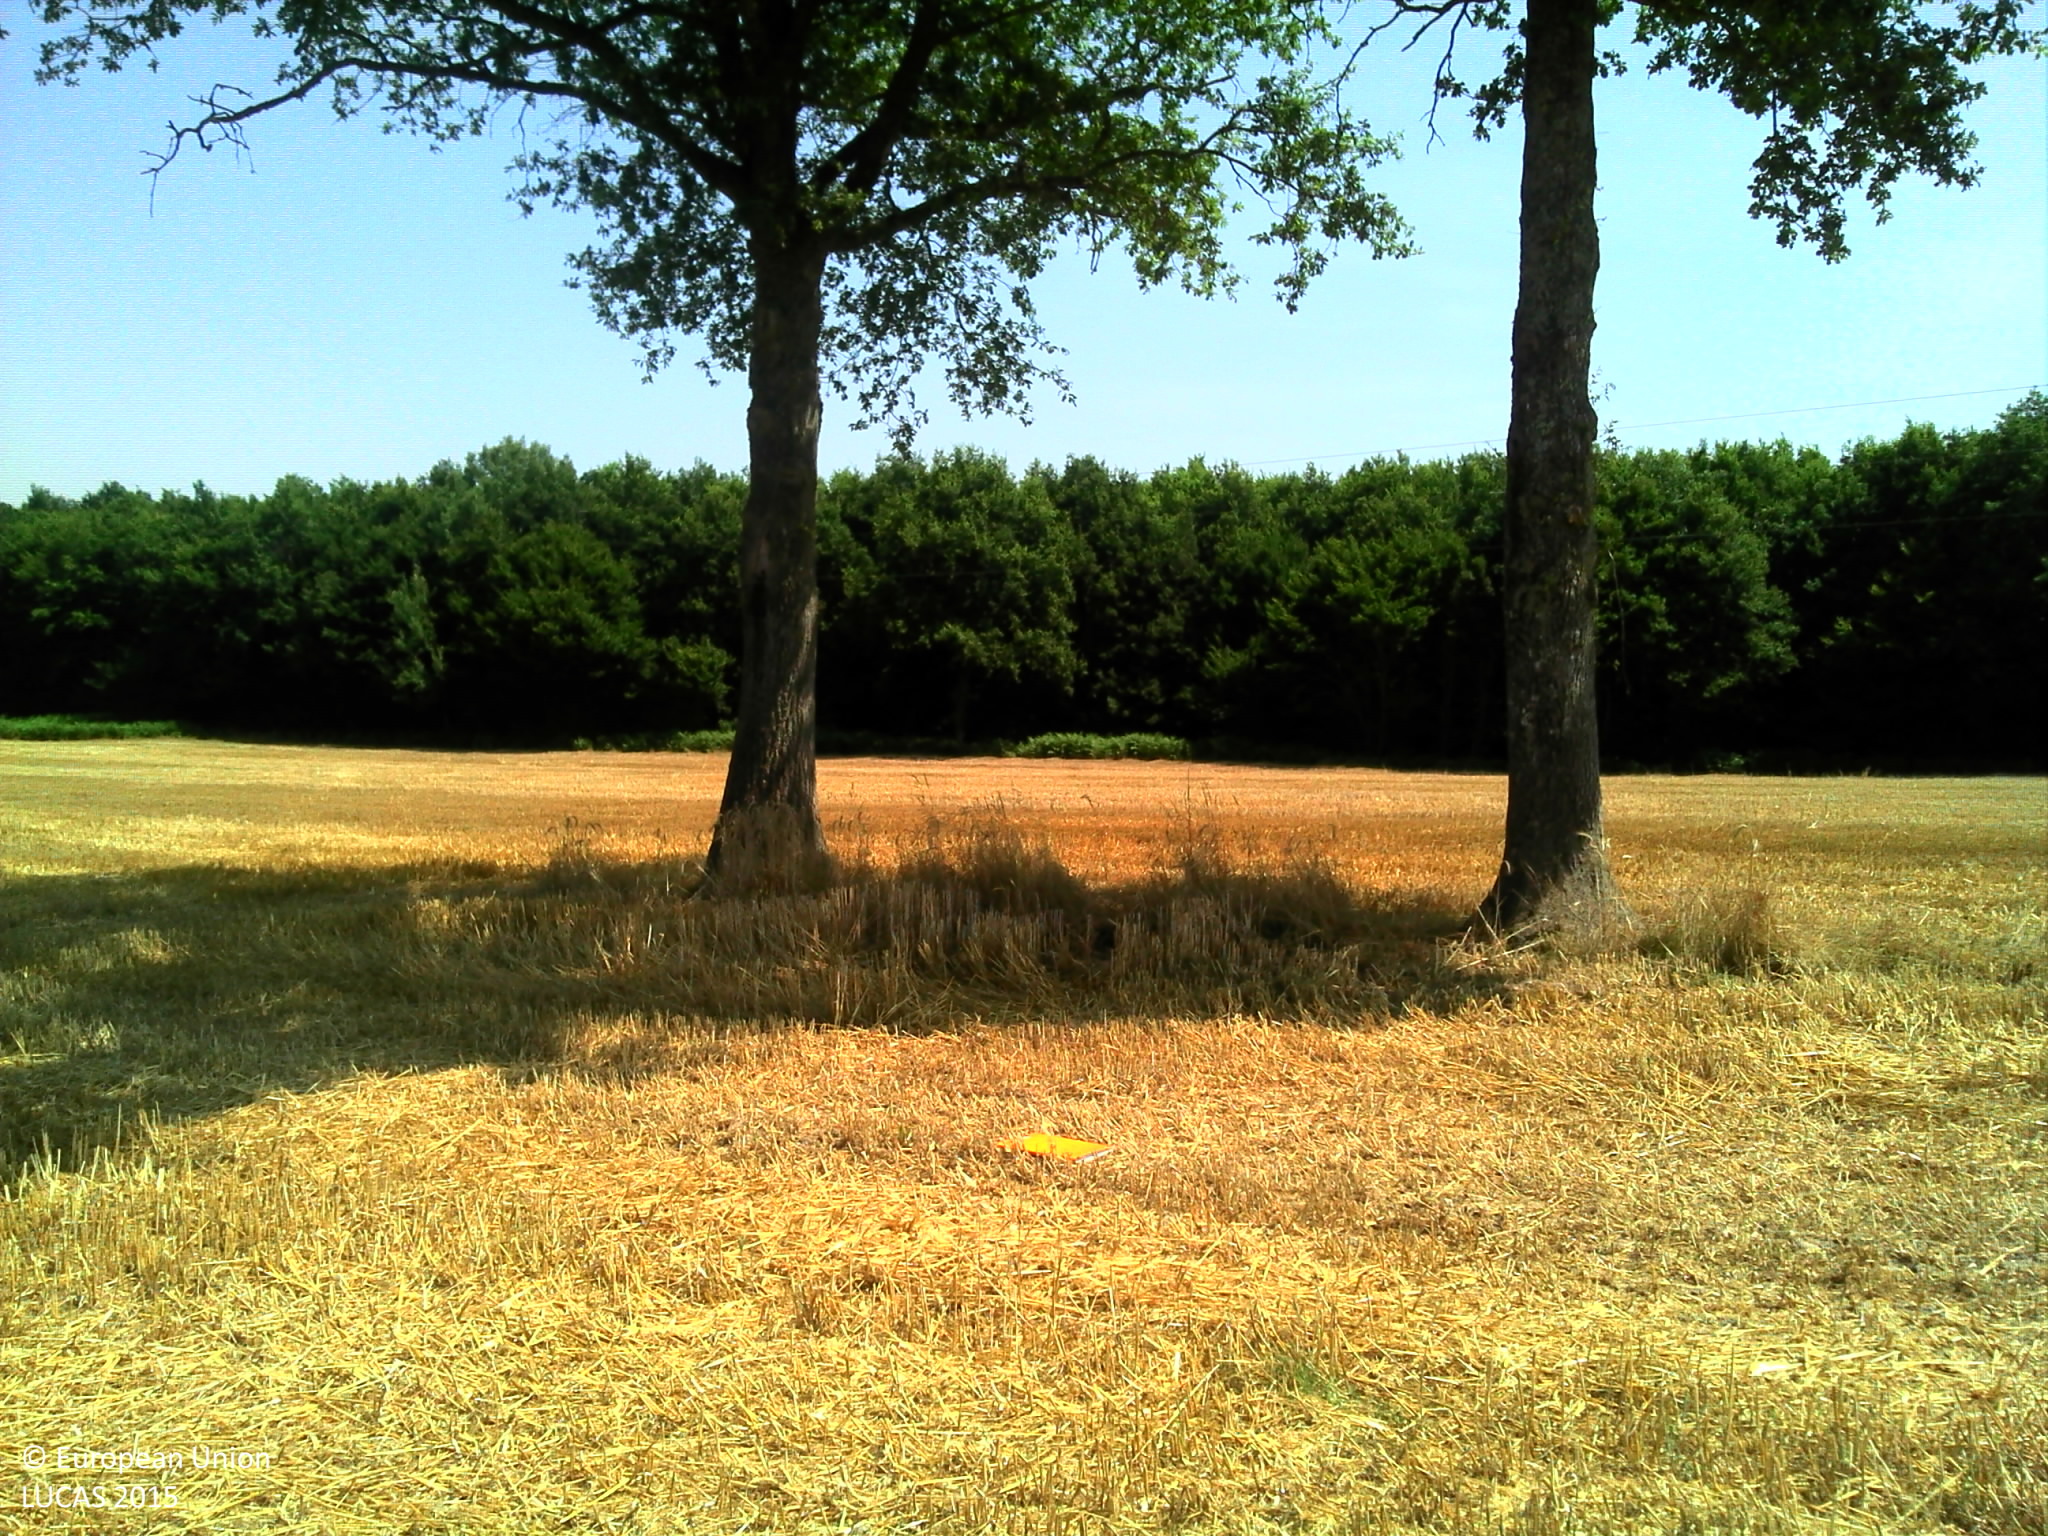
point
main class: Cropland
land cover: Barley
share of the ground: > 75 %
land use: Agriculture (excluding fallow land and kitchen gardens)
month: July
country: FR
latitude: 46.5013
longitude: 2.9997
